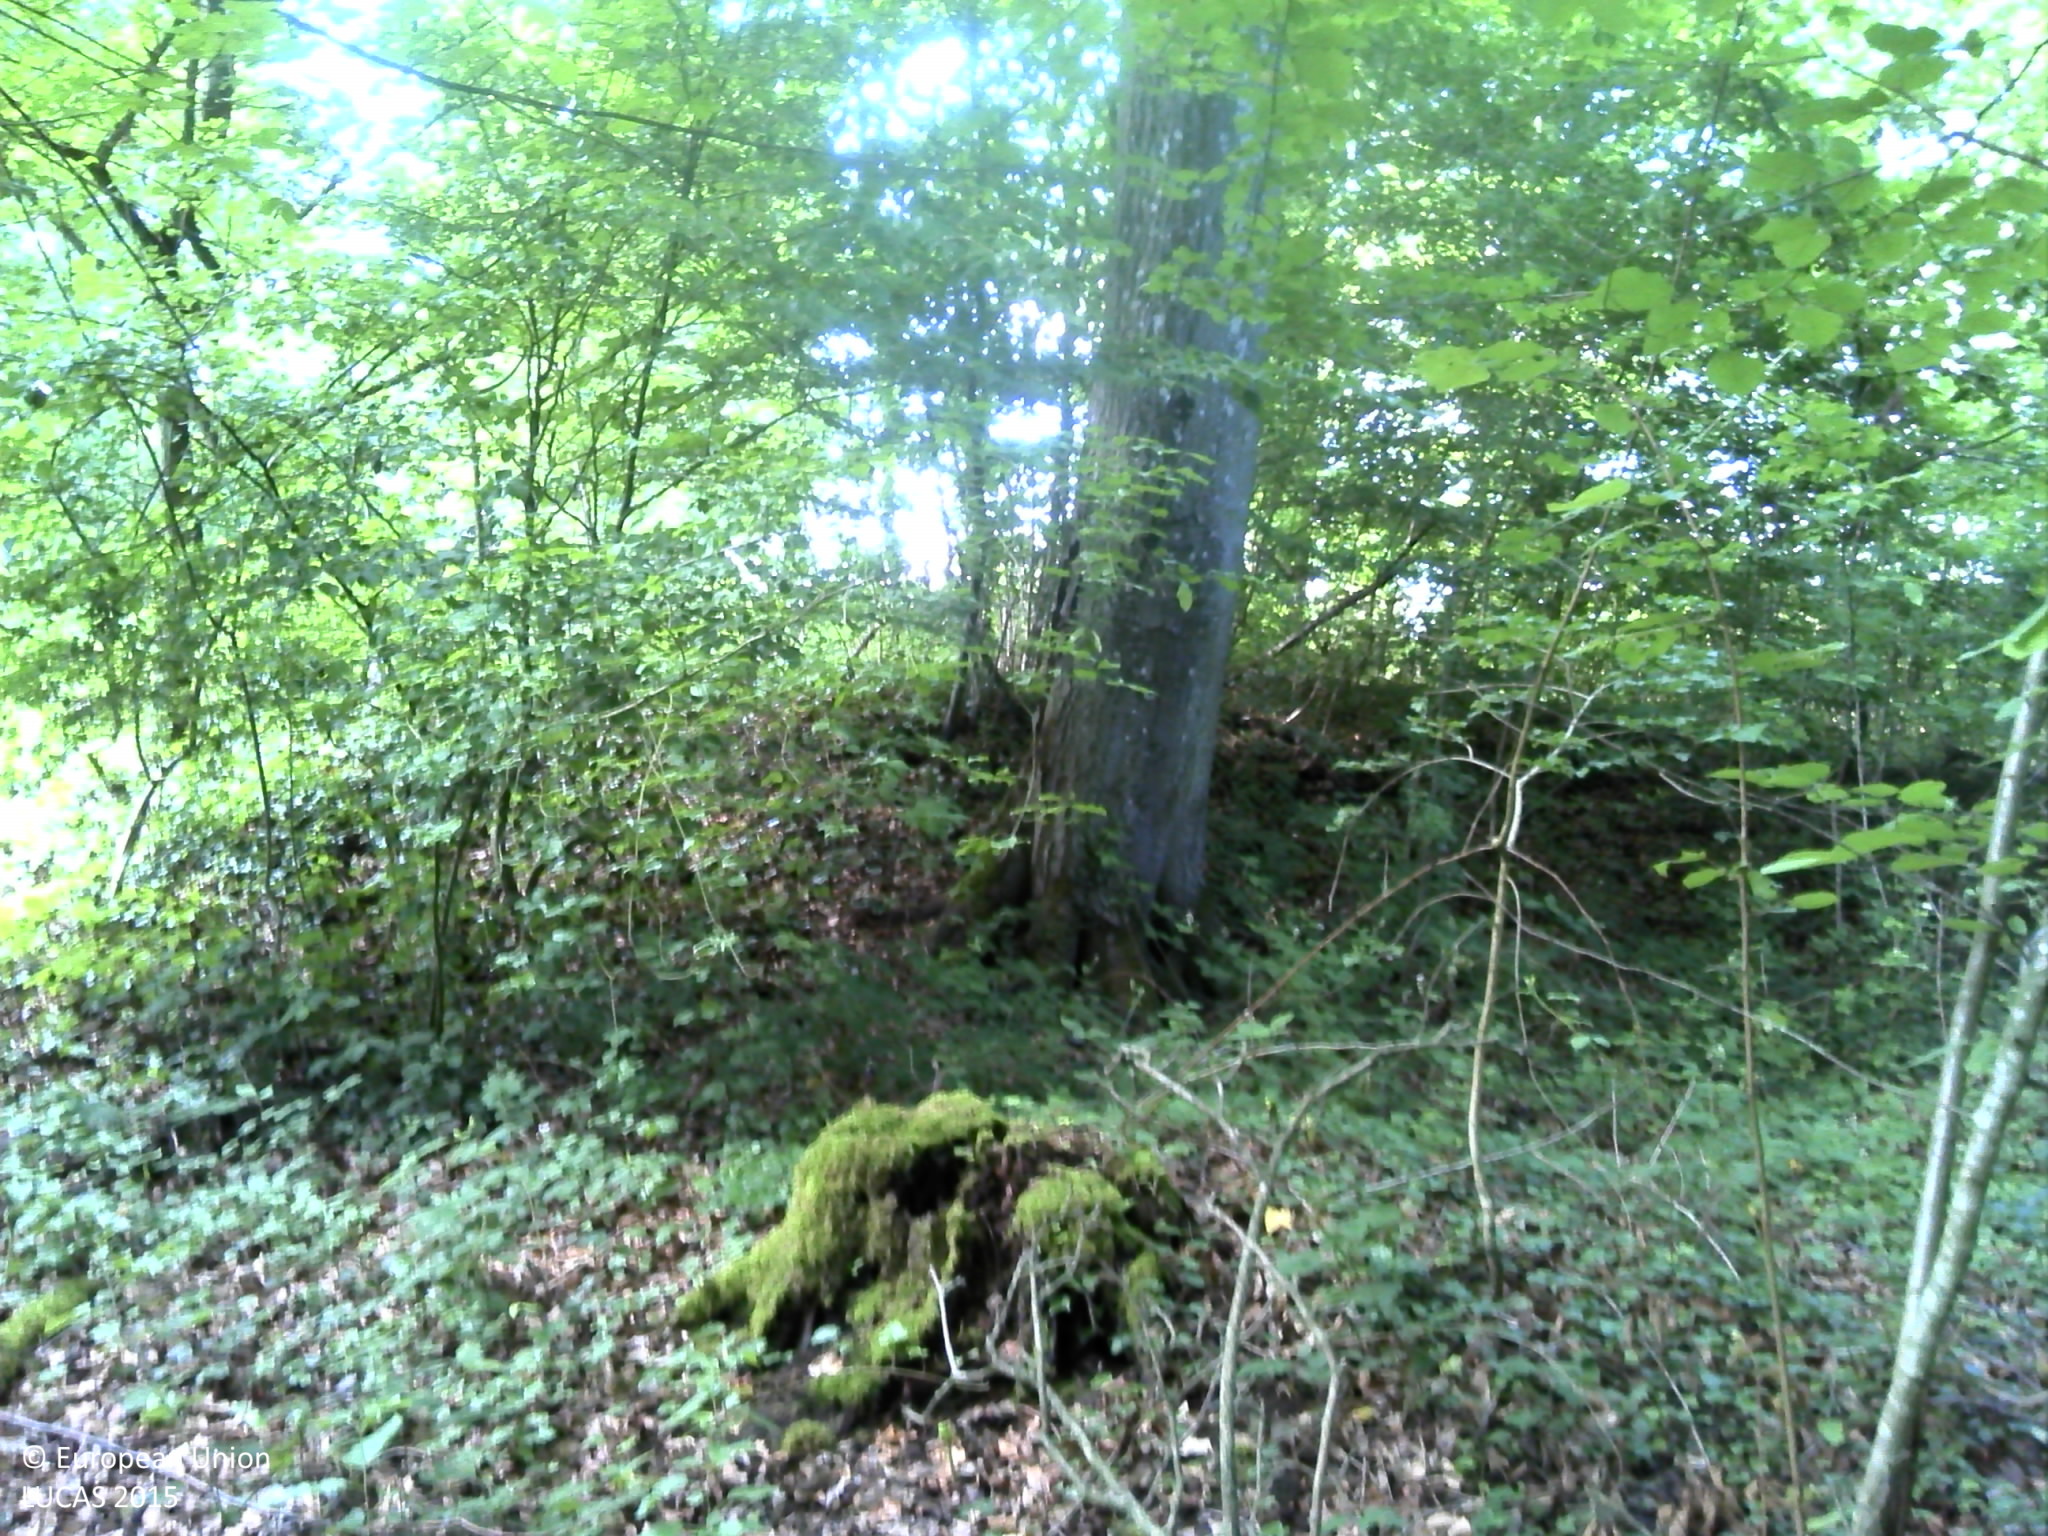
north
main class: Woodland
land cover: Broadleaved woodland
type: beech forest
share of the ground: > 75 %
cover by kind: broadleaved forest trees 100 %
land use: Forestry
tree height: > 5 m
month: June
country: FR
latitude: 49.0230
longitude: 6.7866
